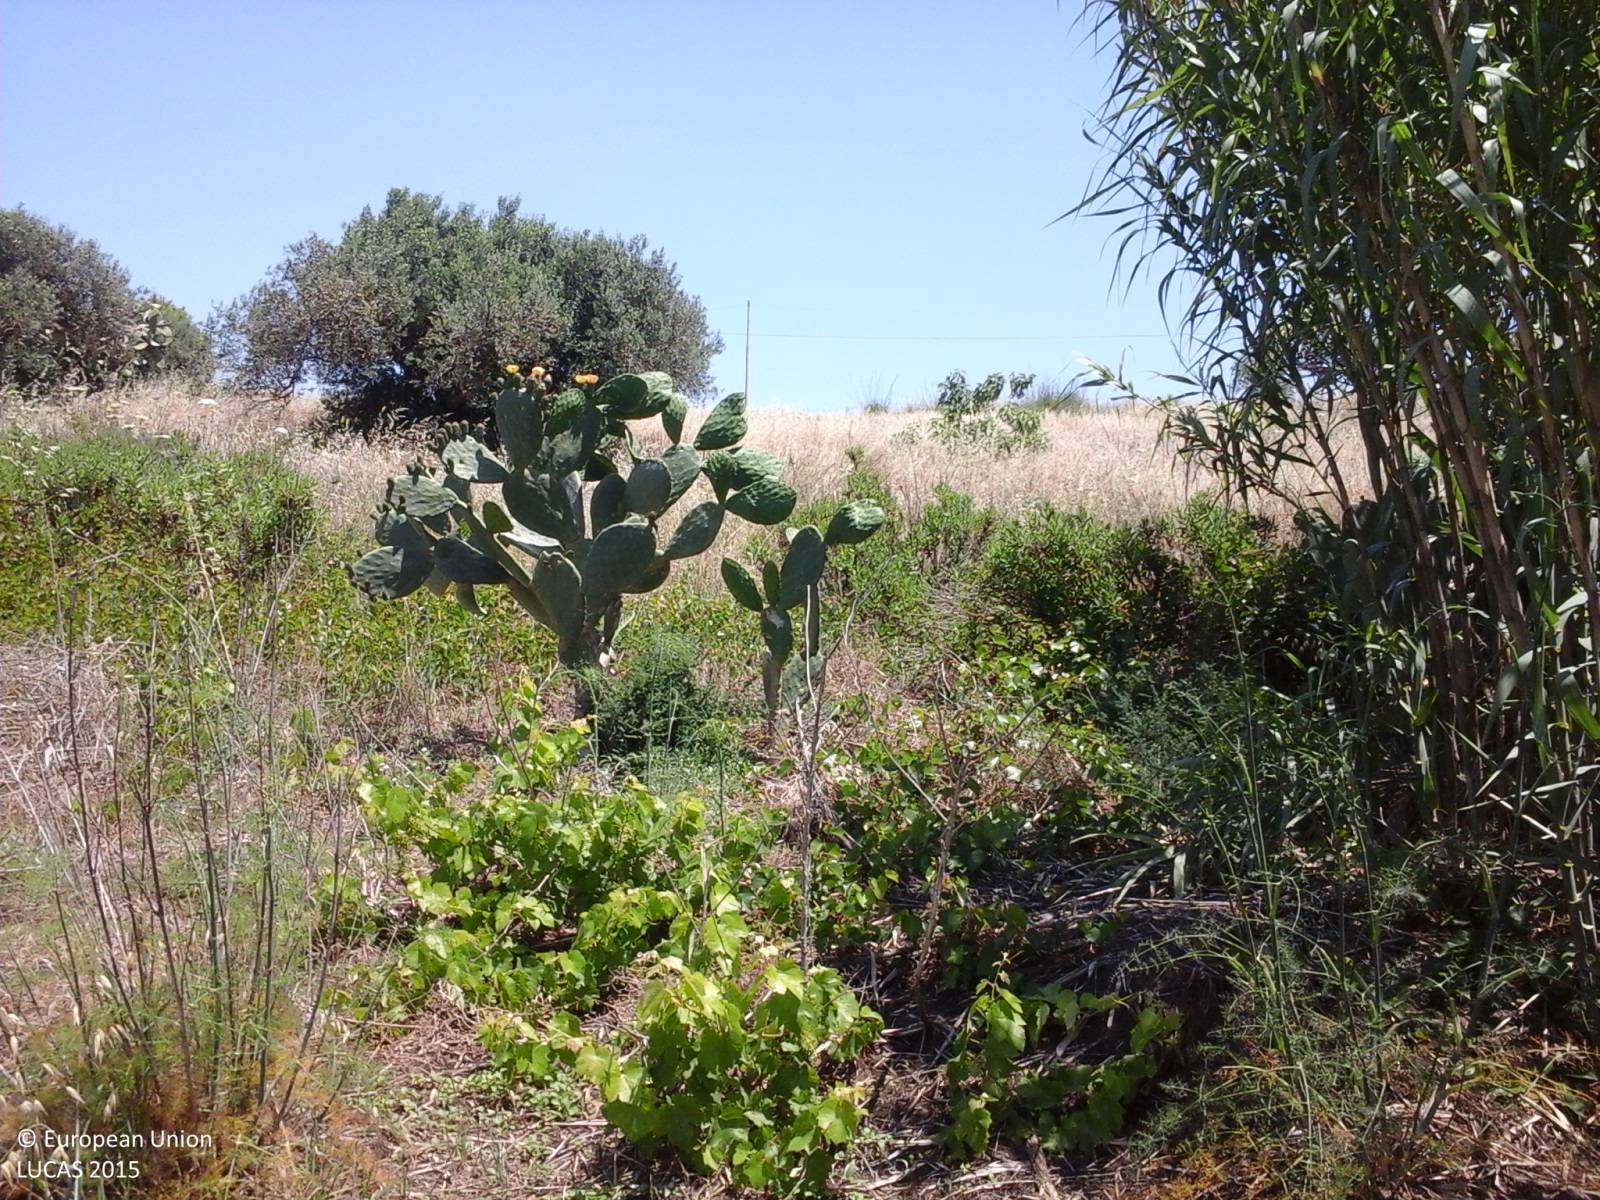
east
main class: Grassland
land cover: Grassland without tree/shrub cover
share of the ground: > 75 %
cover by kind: herbaceous plants 100 %
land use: Abandoned areas
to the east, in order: Grassland without tree/shrub cover; Electric lines; Fences; Paved roads, cycling and walking lanes; Fences; Vineyards; Fences; Olive groves; Other fresh vegetables; Electric lines; Fences; Paved roads, cycling and walking lanes; Fences; Spontaneously vegetated surfaces; Electric lines; Spontaneously vegetated surfaces; Artificial constructions in urban areas
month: June
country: IT
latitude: 37.9924
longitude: 12.9507
